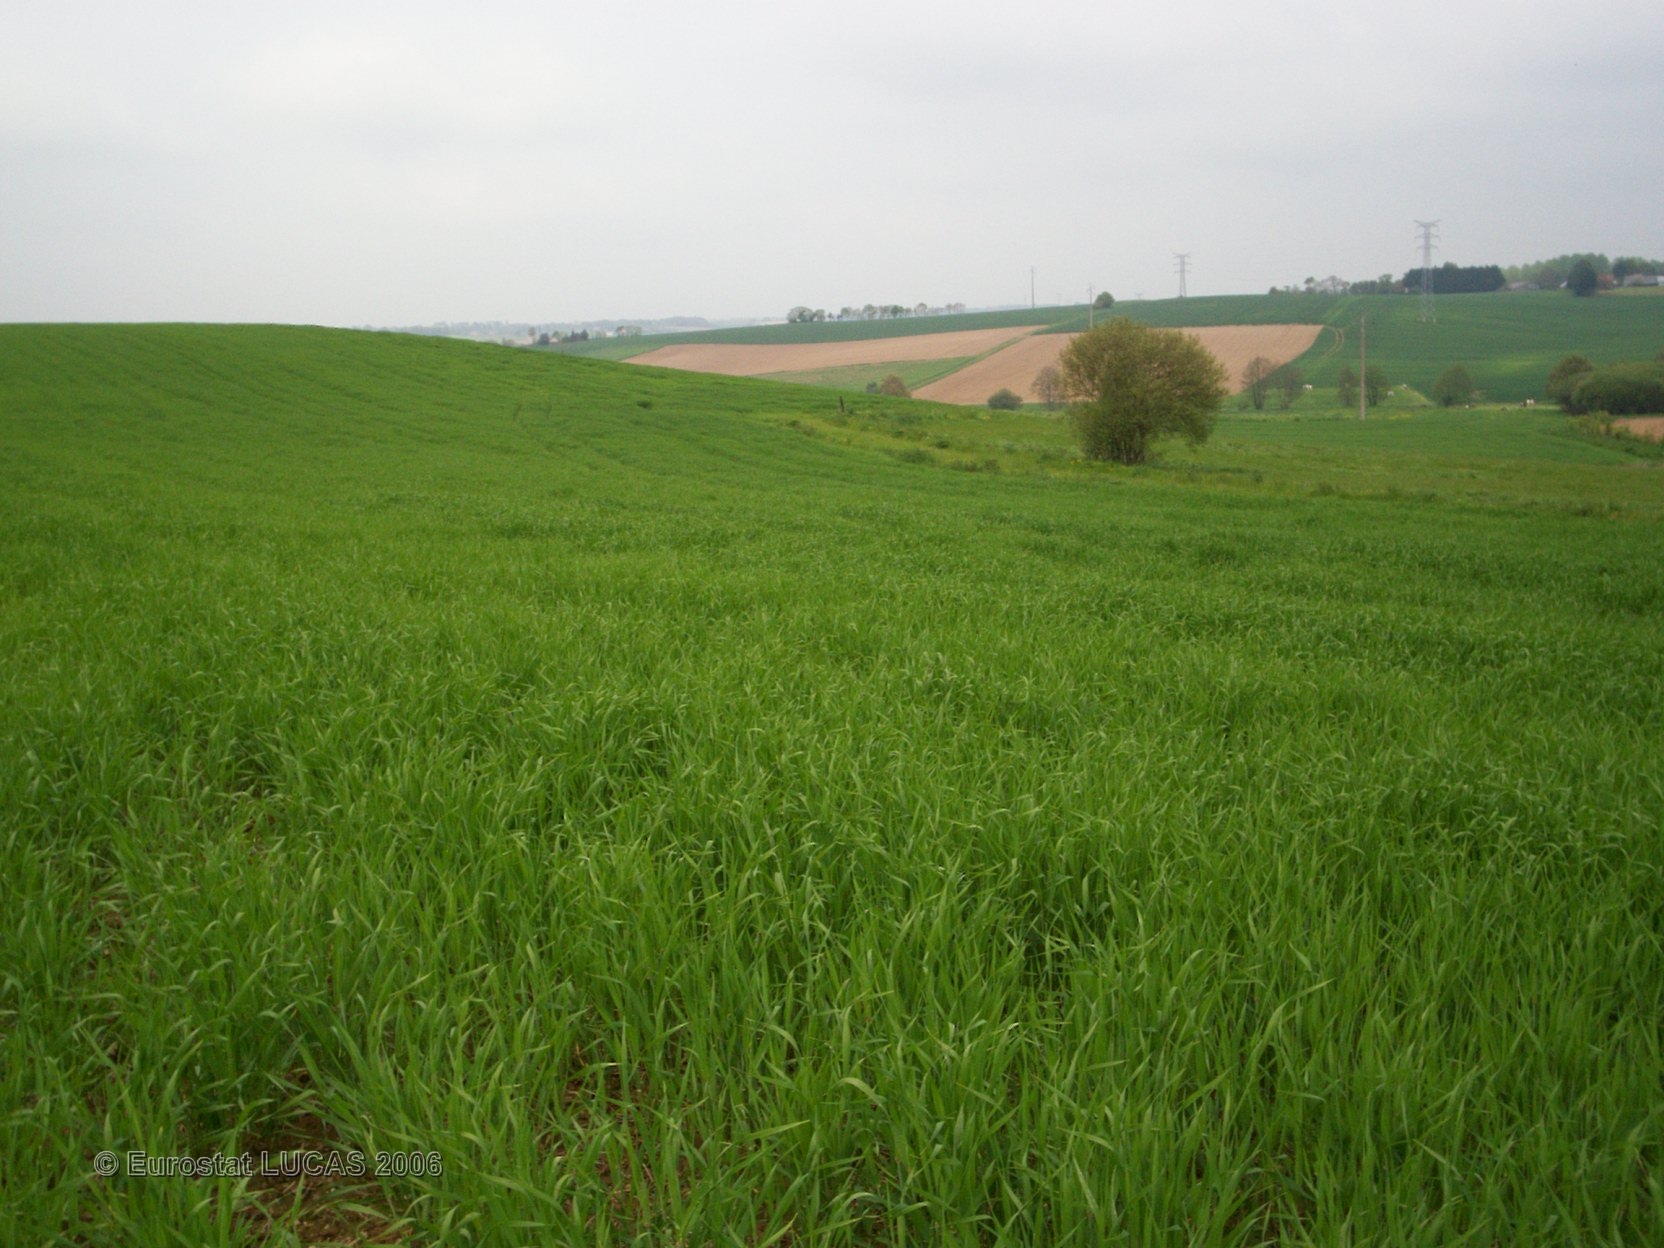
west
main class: Cropland
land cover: Barley
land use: Agriculture (excluding fallow land and kitchen gardens)
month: May
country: FR
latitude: 48.1661
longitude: -2.7982
